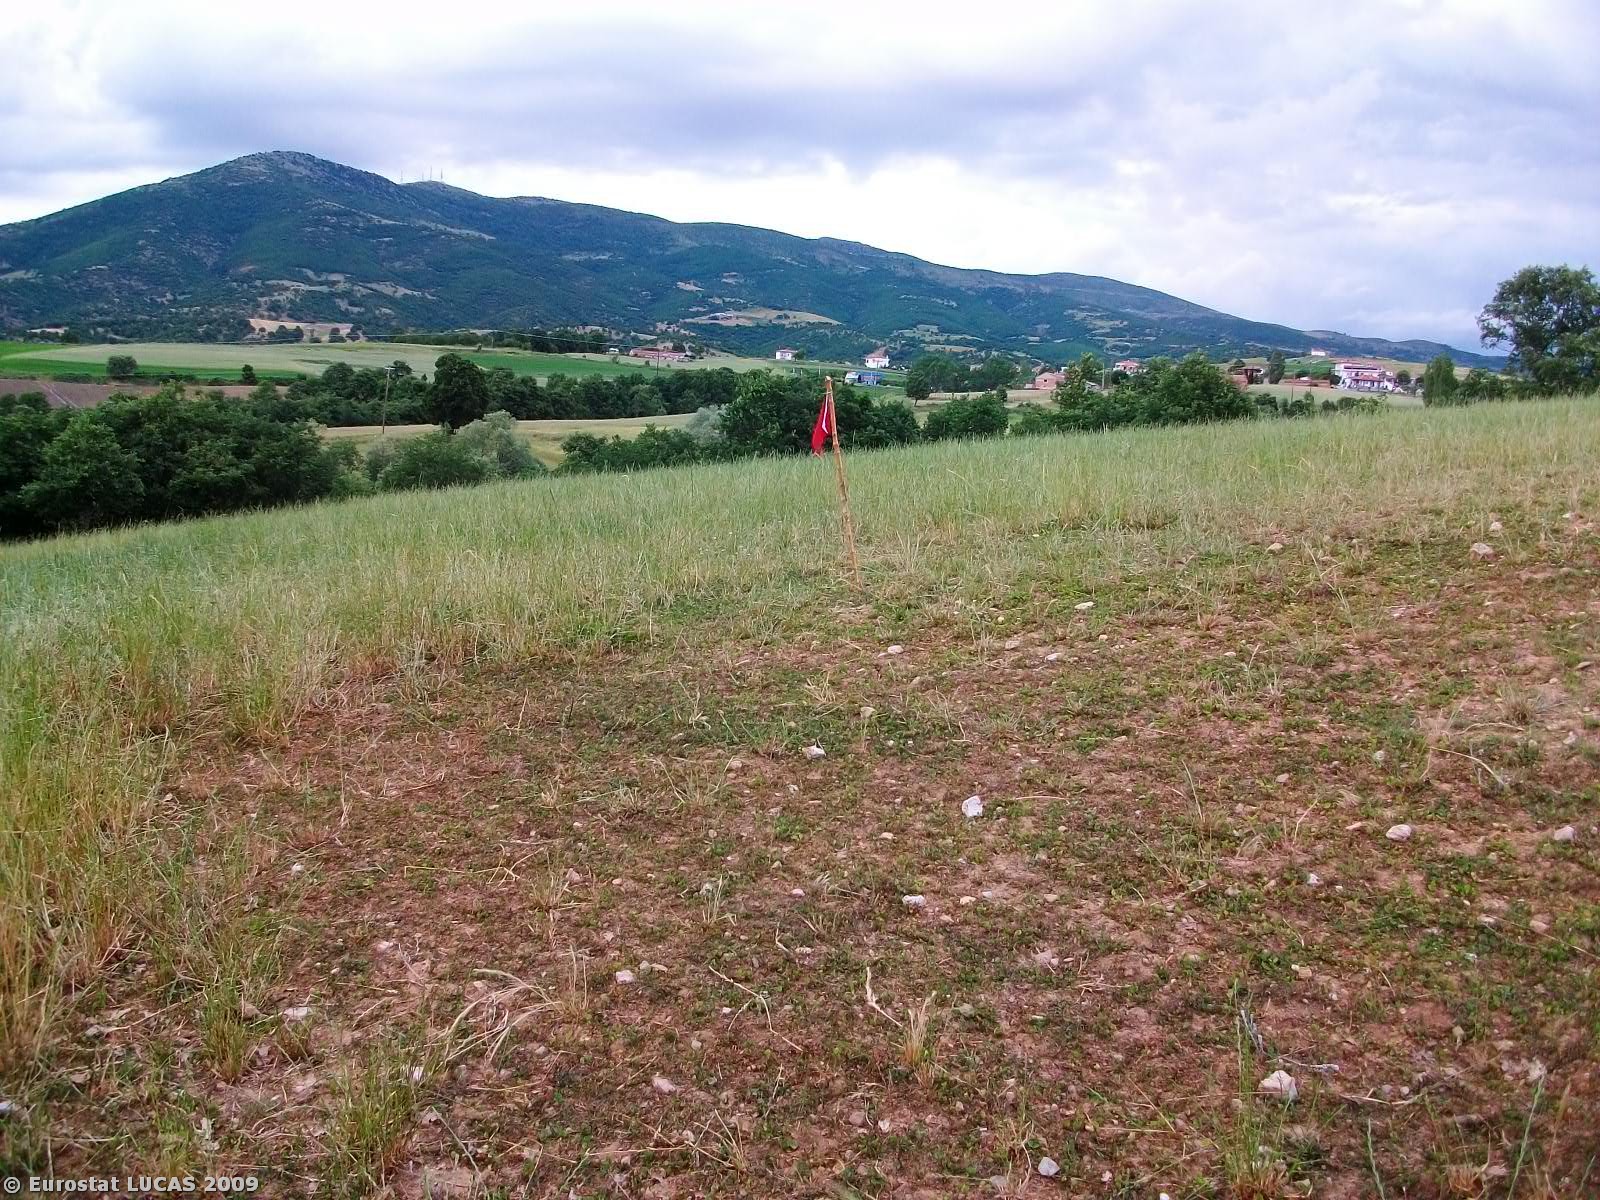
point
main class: Grassland
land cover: Spontaneously vegetated surfaces
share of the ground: > 75 %
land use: Fallow land
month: June
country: GR
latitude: 39.9038
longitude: 21.7660
